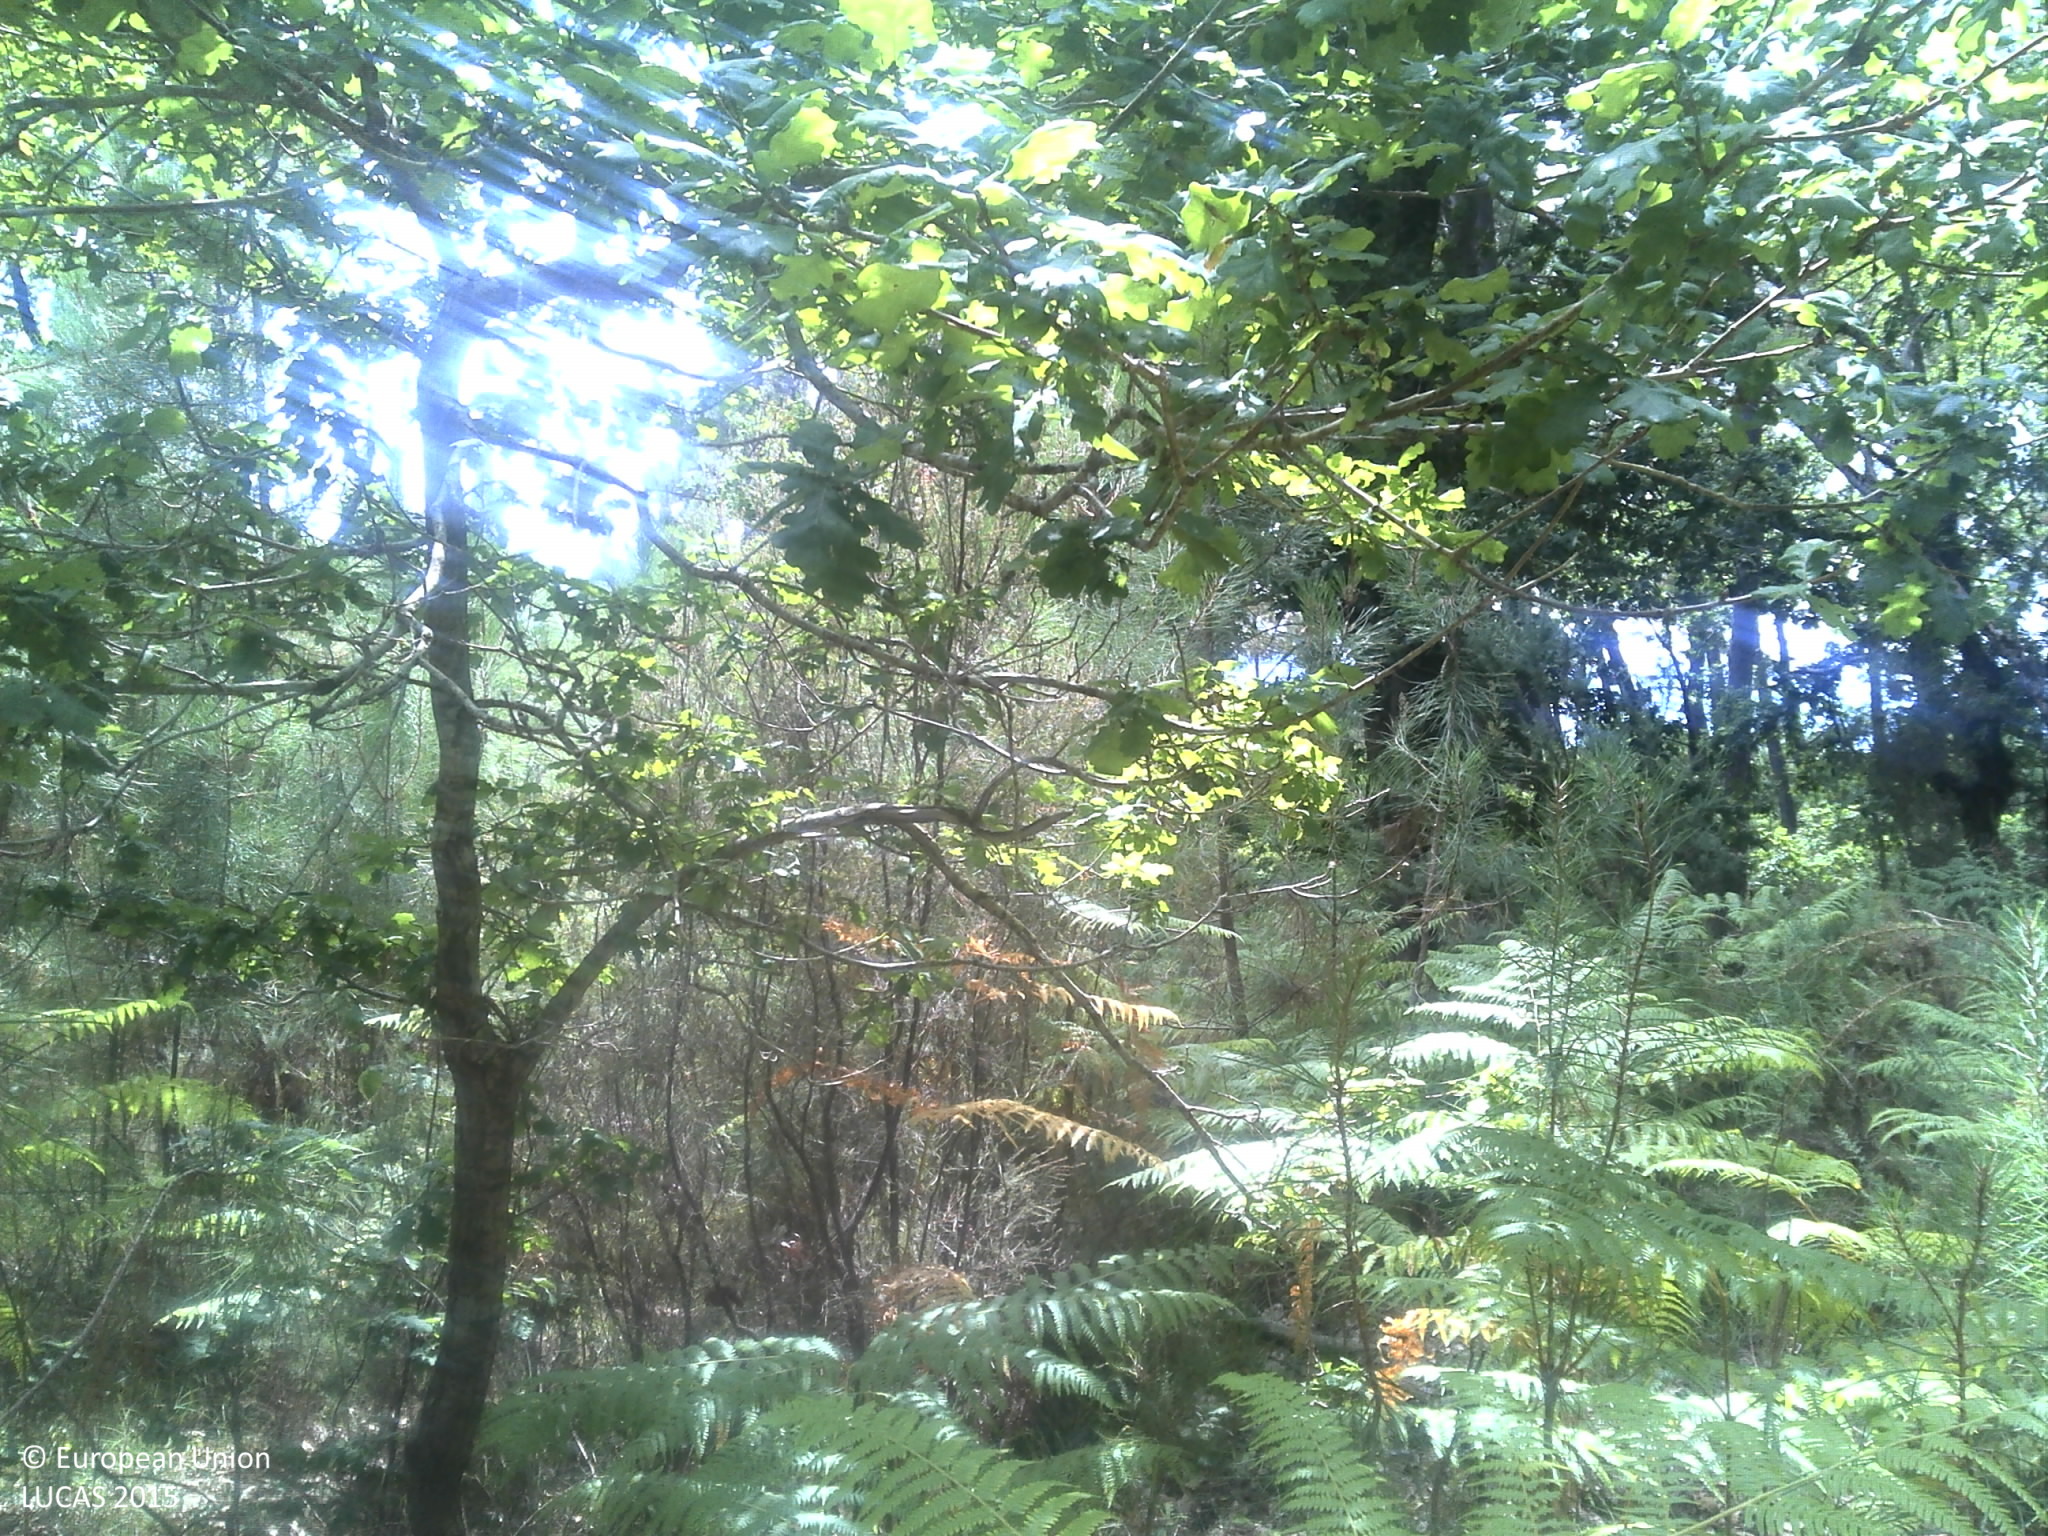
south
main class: Woodland
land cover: Pine dominated mixed woodland
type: coniferous forest of the mediterranean region
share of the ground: > 75 %
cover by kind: broadleaved forest trees 45 %, shrubs 20 %, coniferous forest trees 15 %, herbaceous plants 10 %, consolidated bare surface 10 %
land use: Forestry
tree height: > 5 m
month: July
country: FR
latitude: 45.3871
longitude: -1.1263
